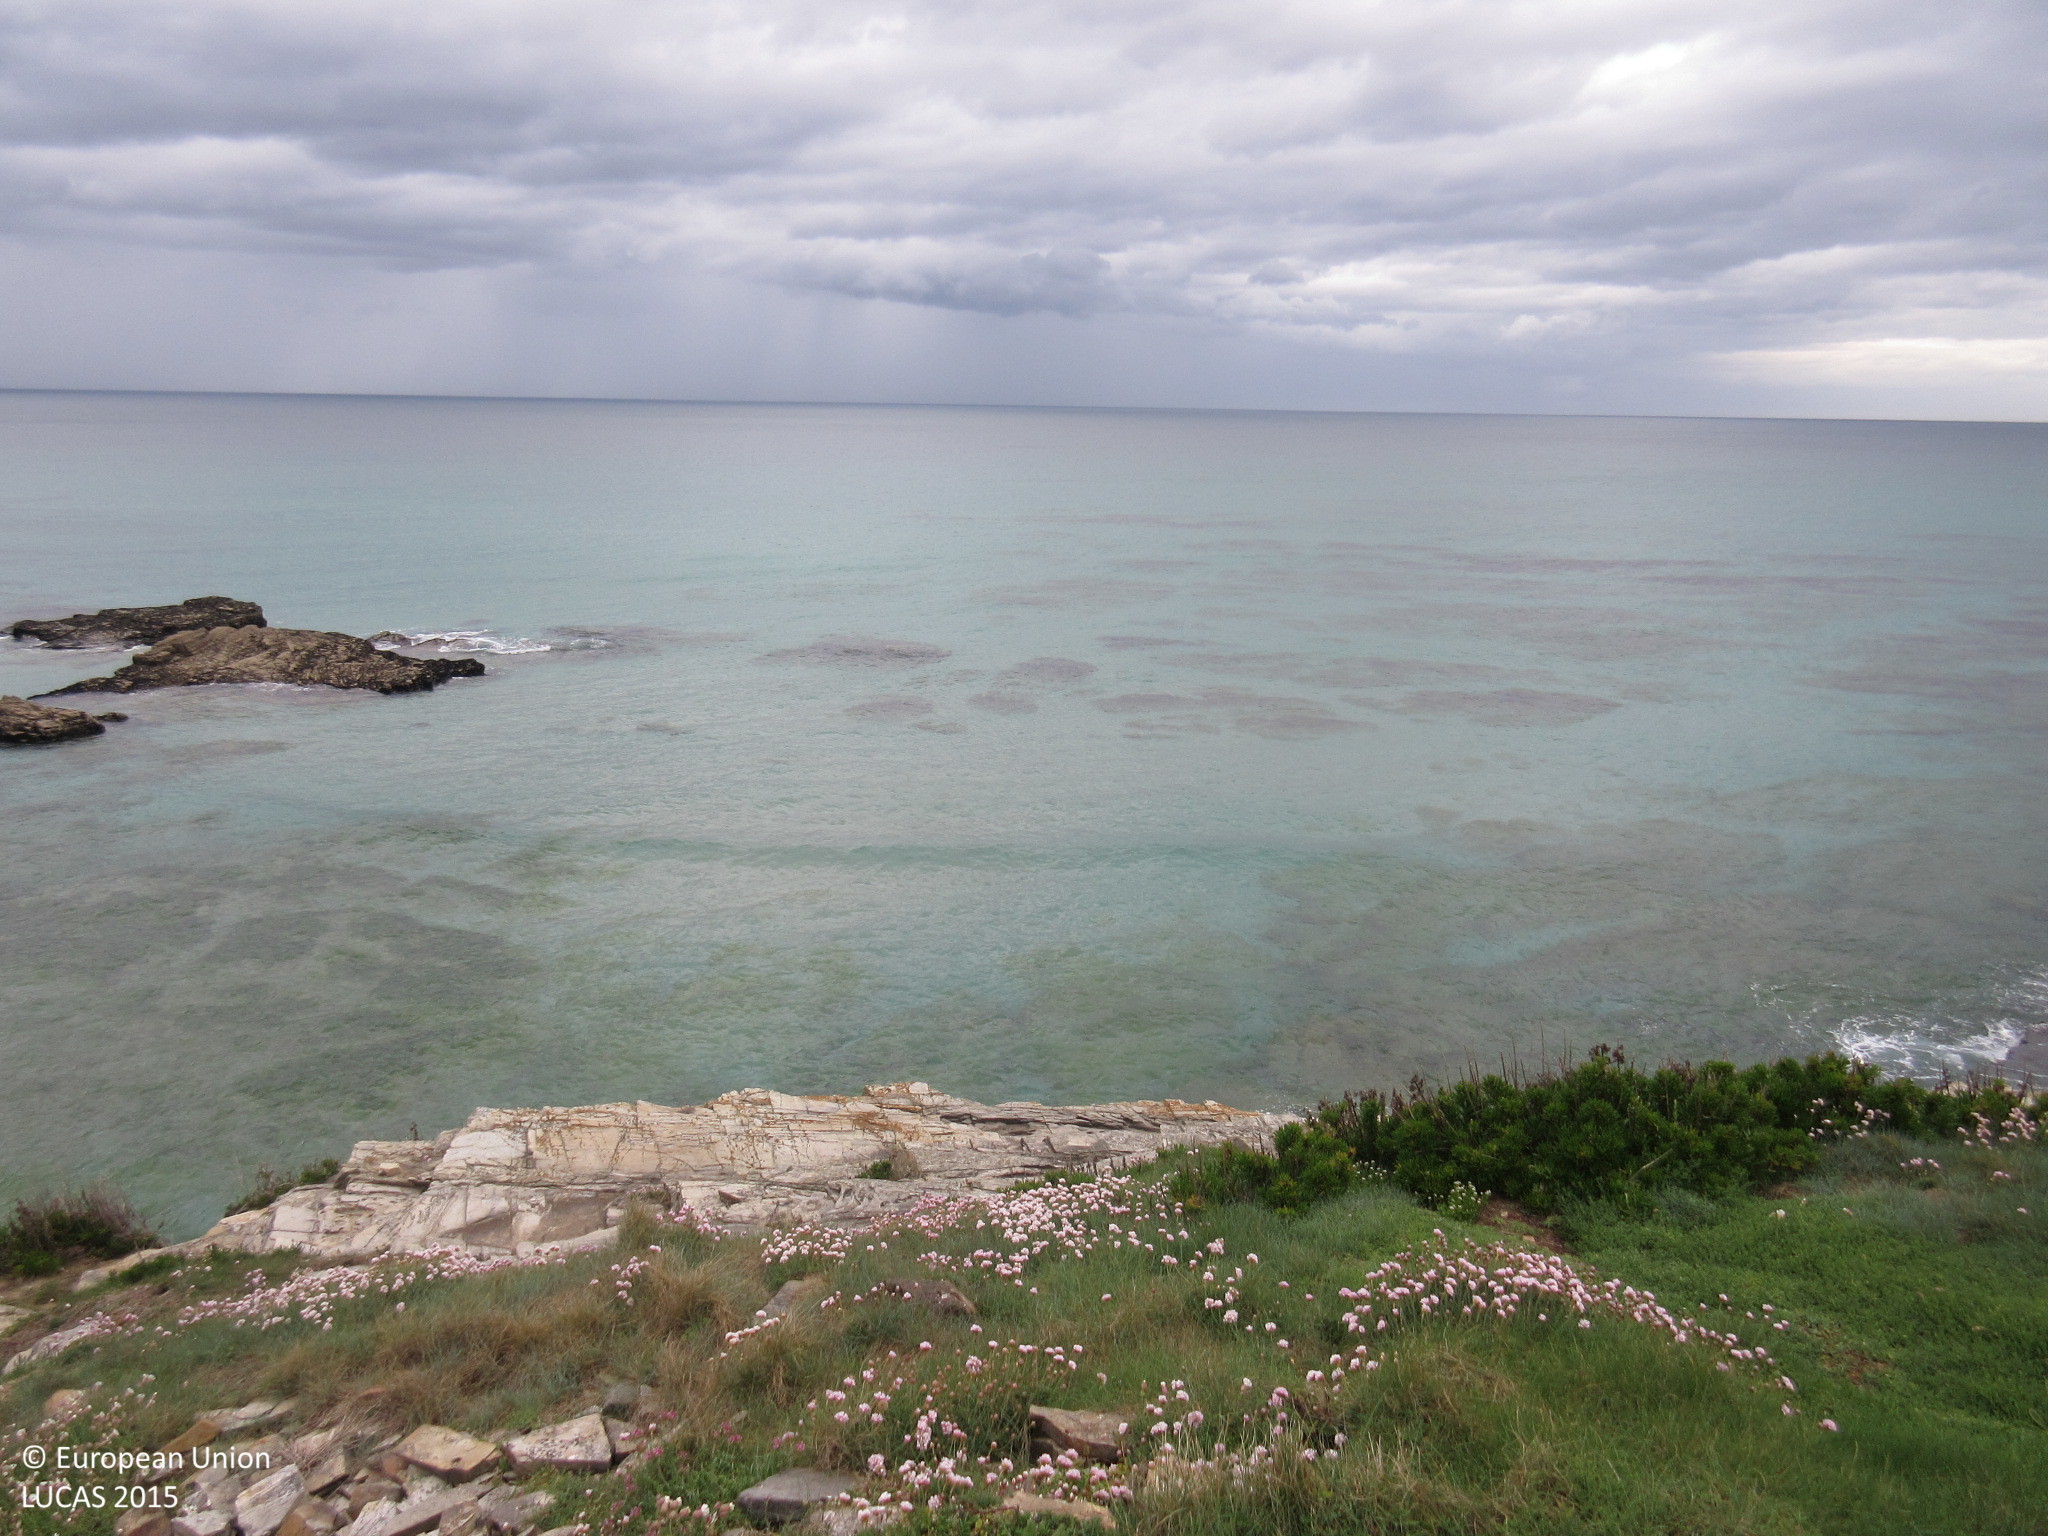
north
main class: Shrubland
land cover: Shrubland without tree cover
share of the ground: > 75 %
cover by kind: herbaceous plants 80 %, shrubs 20 %
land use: Semi-natural and natural areas not in use
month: April
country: ES
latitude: 43.5553
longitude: -7.1427
